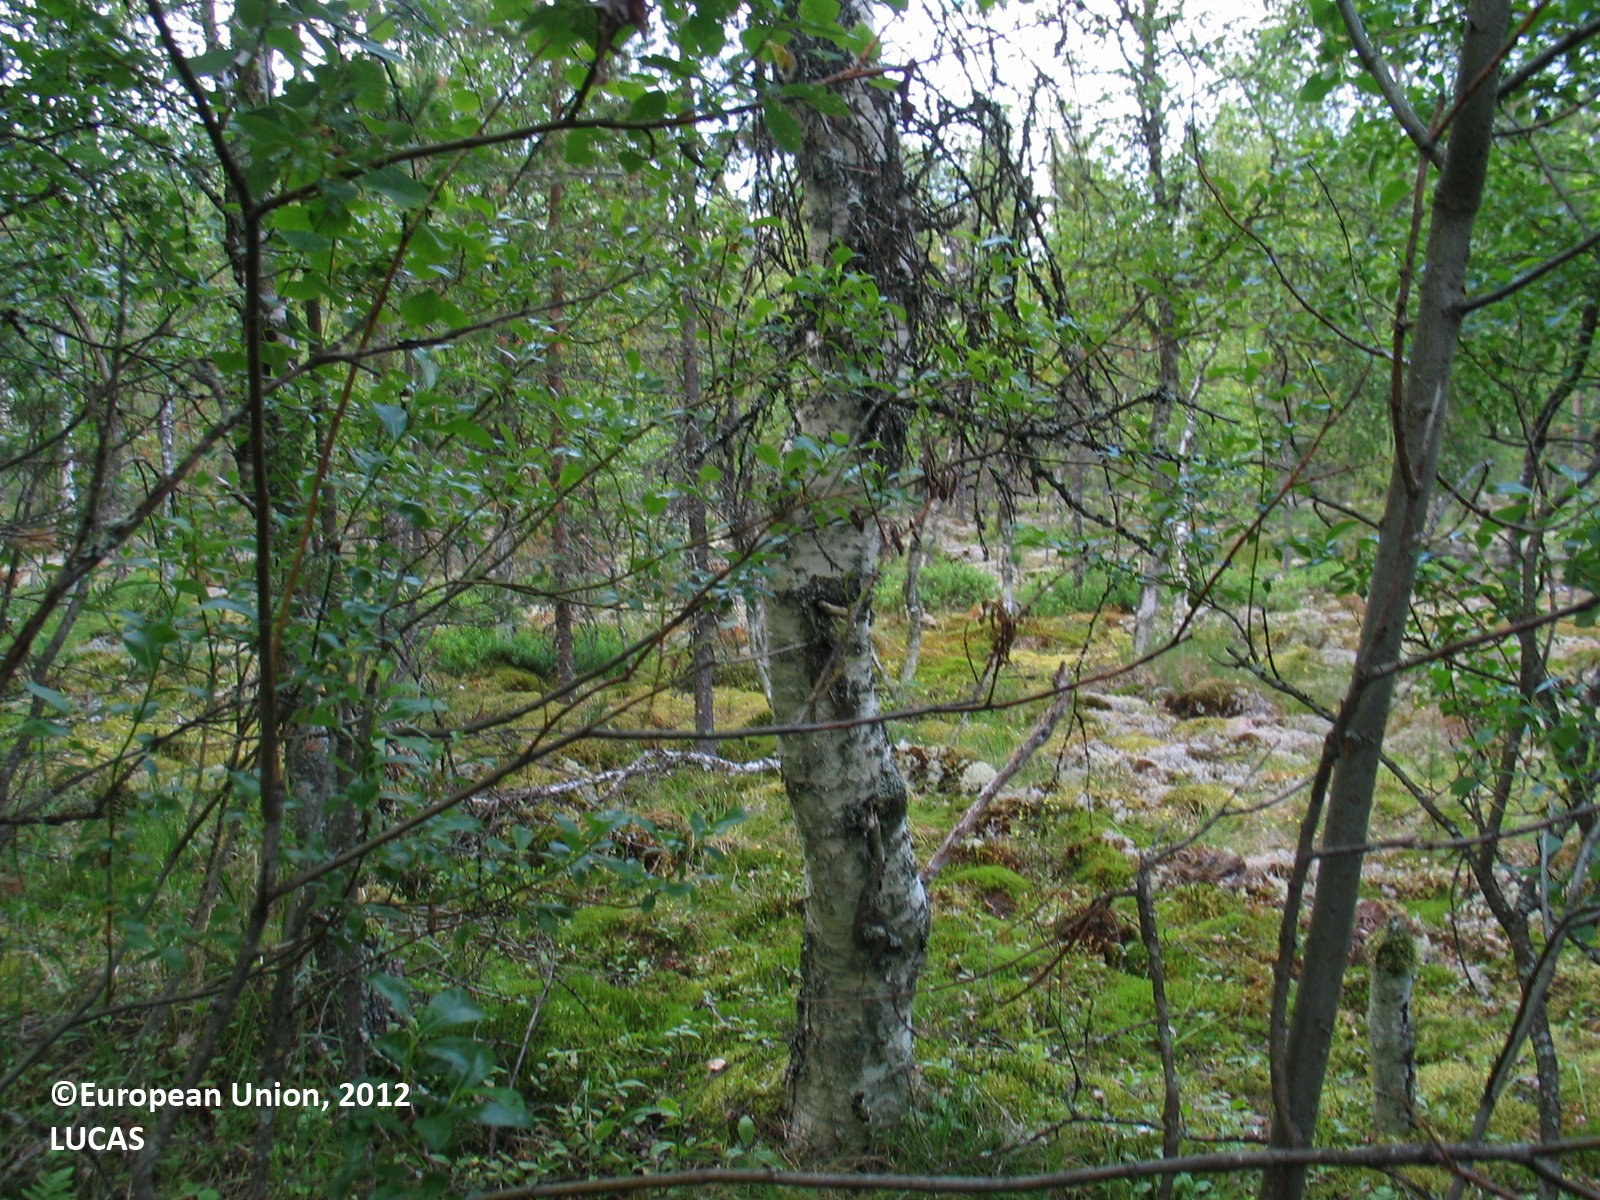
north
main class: Woodland
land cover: Other mixed woodland
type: boreal forest
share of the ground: 25 - 50 %
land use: Semi-natural and natural areas not in use
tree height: > 5 m
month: July
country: FI
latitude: 64.5294
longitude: 26.4736
